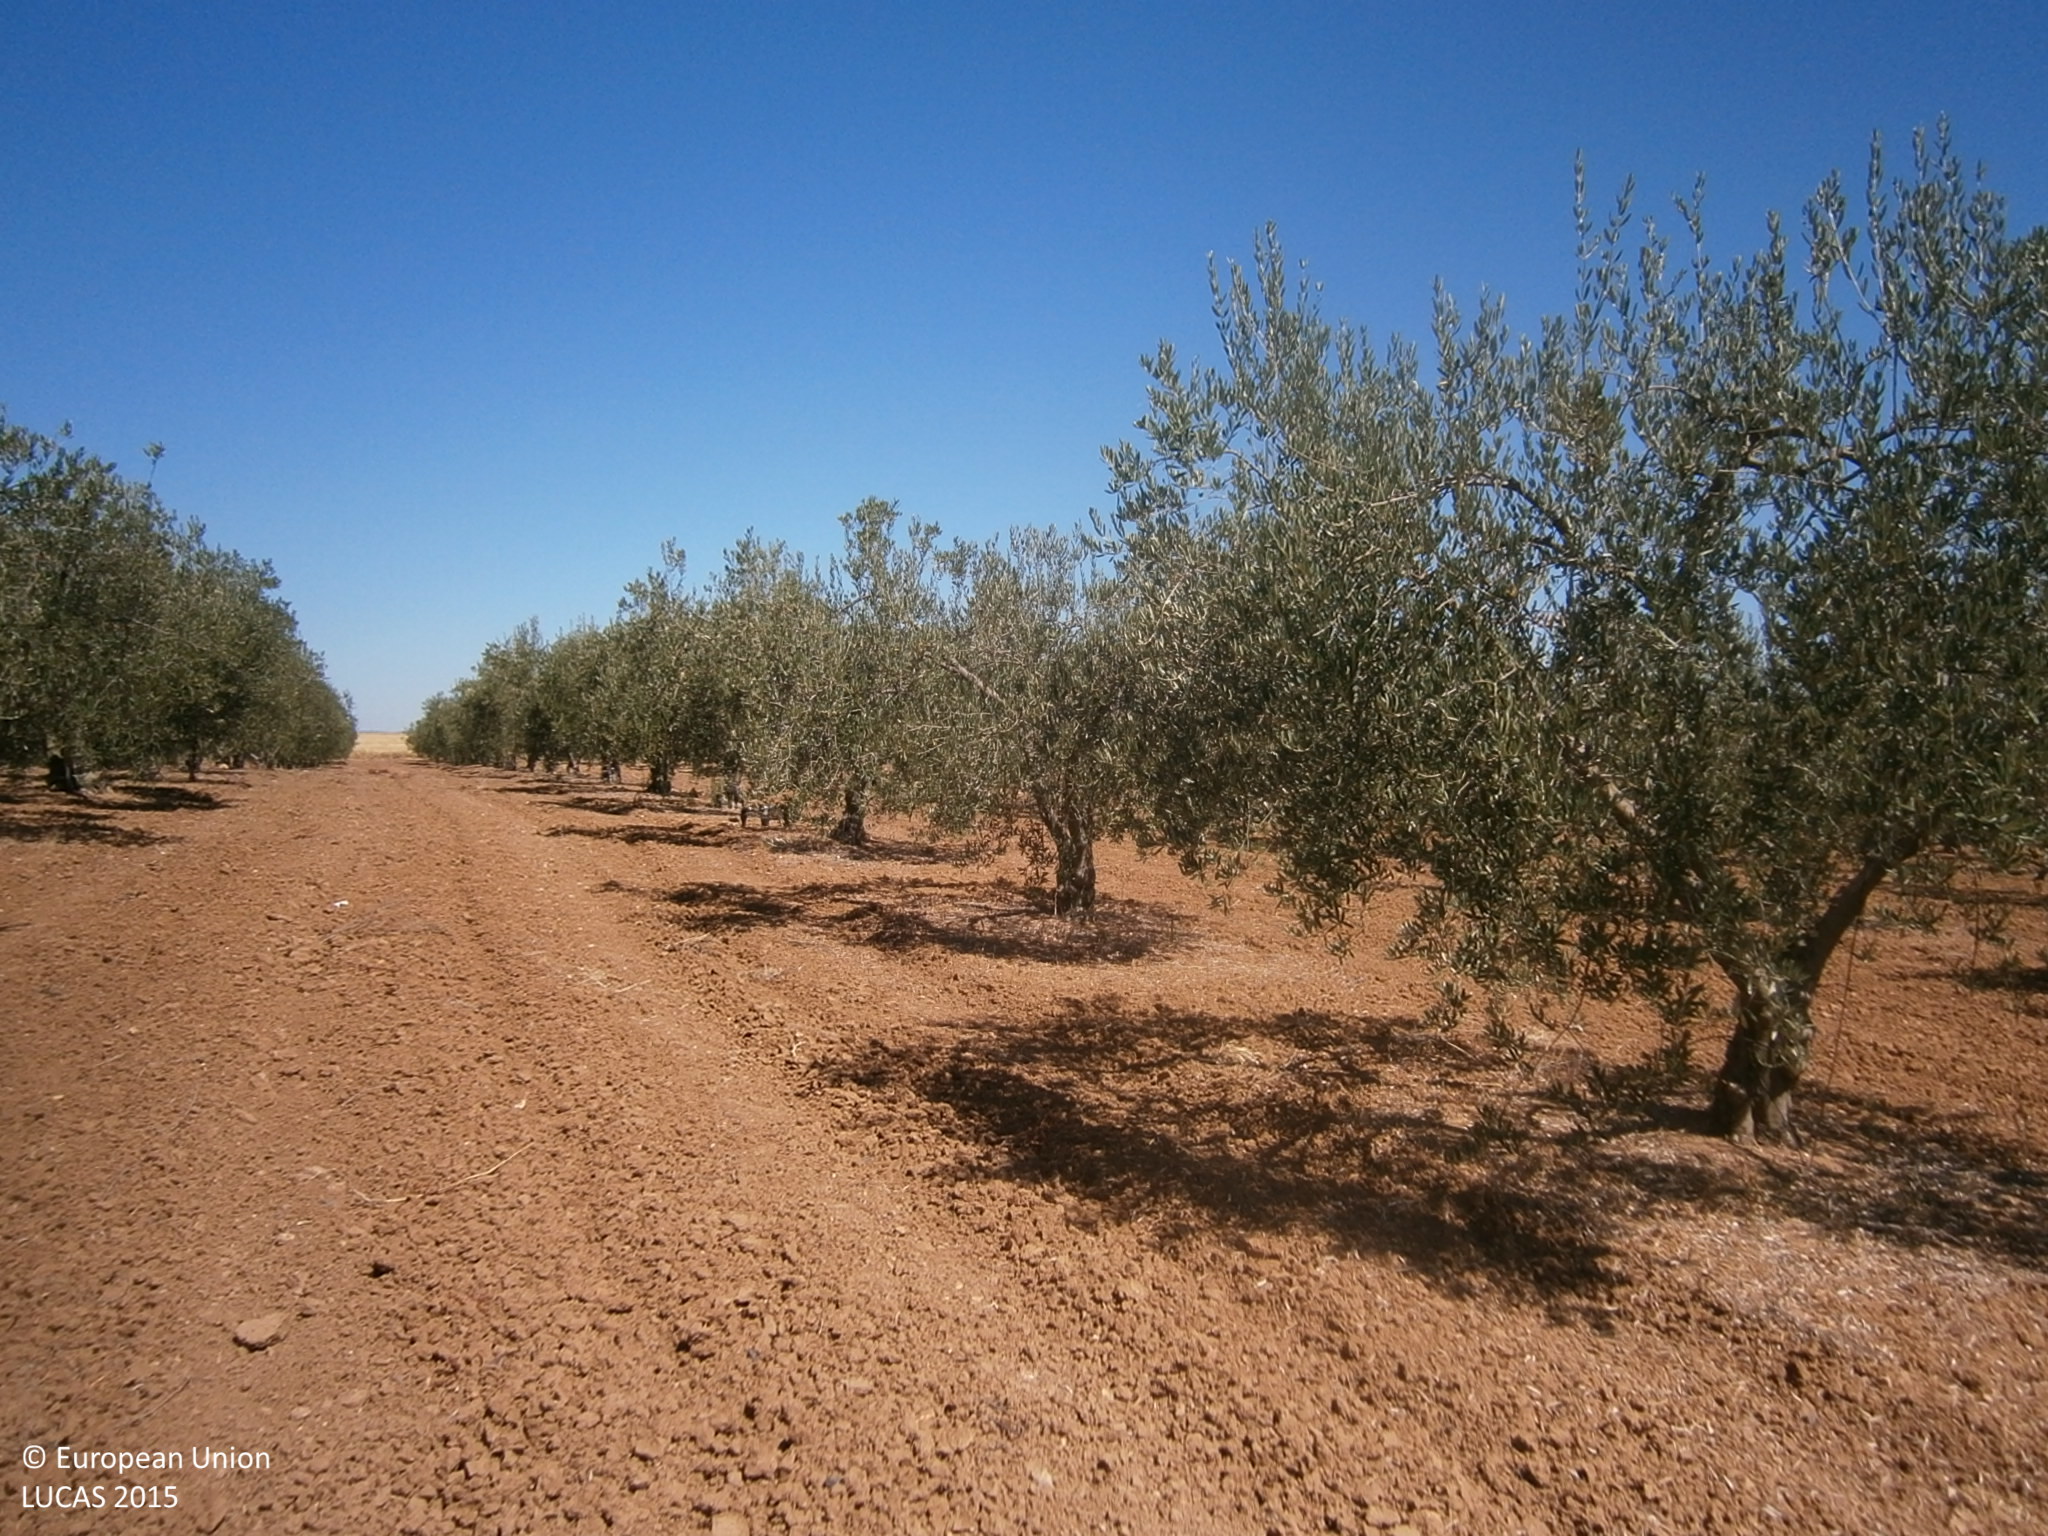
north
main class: Cropland
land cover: Olive groves
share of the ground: 25 - 50 %
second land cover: Other bare soil
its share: > 75 %
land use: Agriculture (excluding fallow land and kitchen gardens)
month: July
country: ES
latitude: 38.9165
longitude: -7.0137
